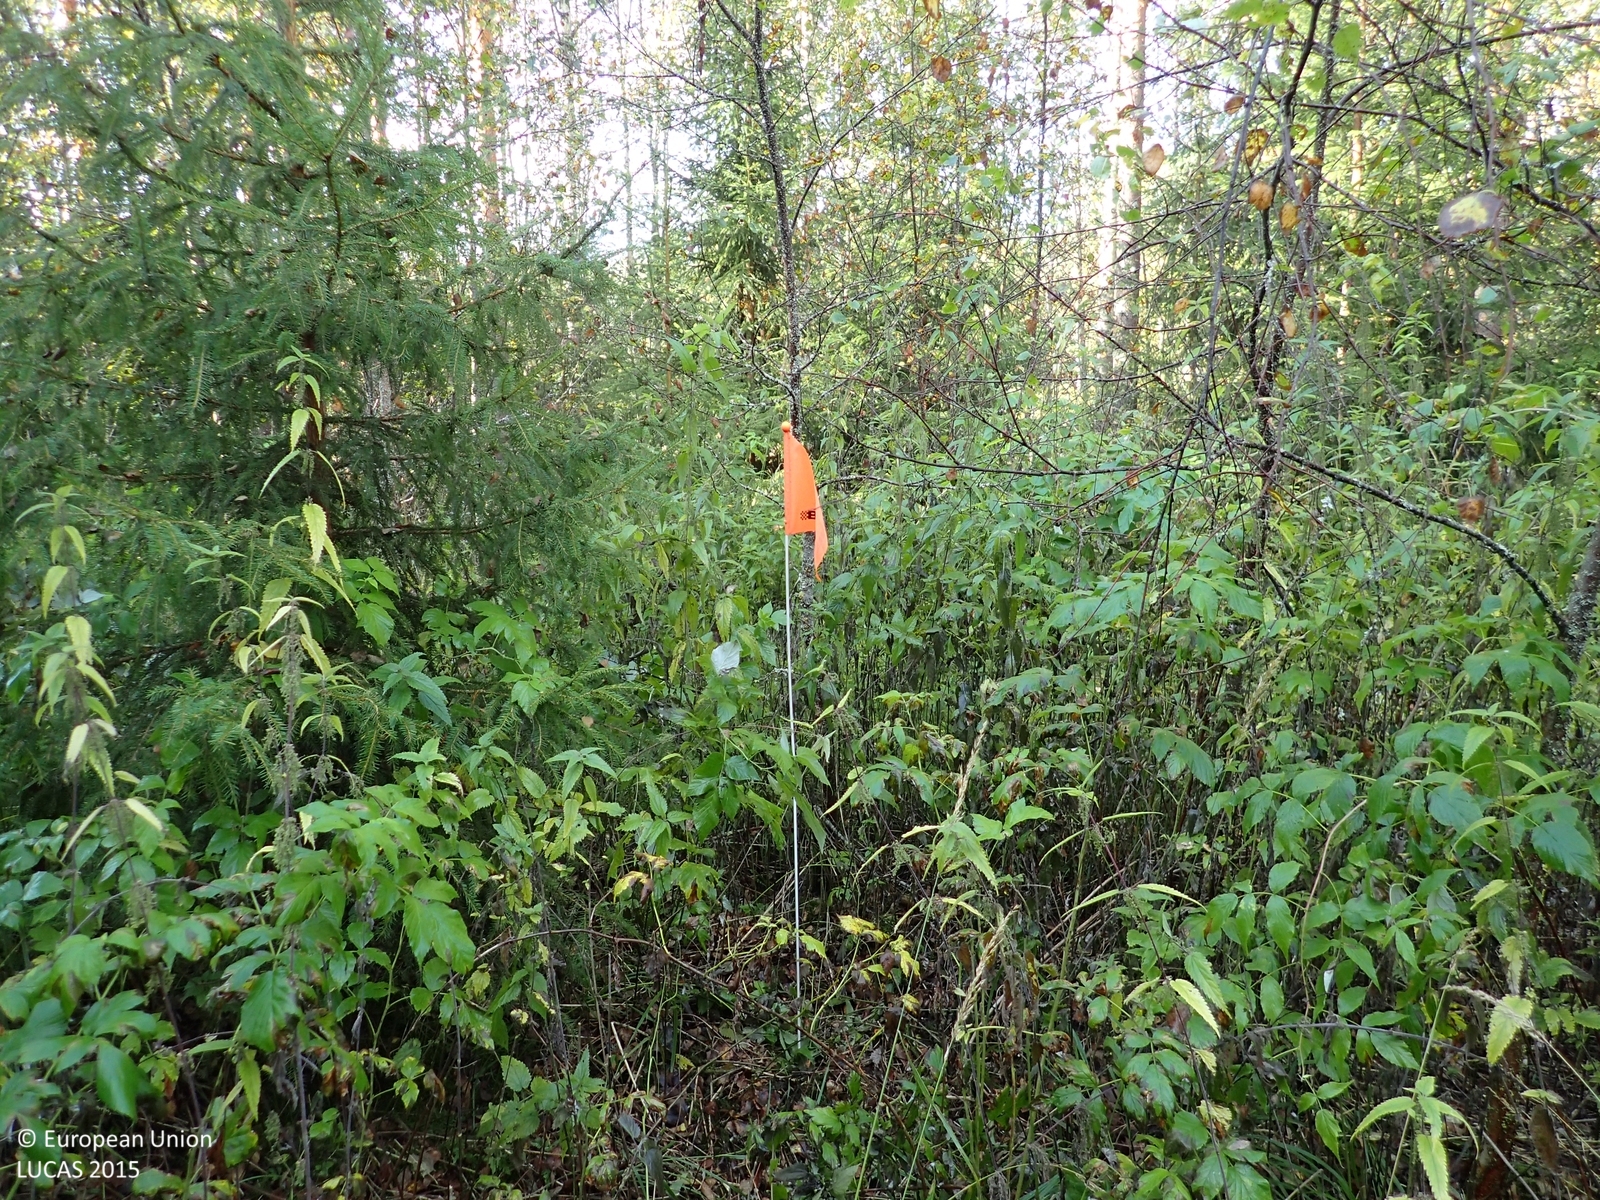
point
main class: Woodland
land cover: Spruce dominated mixed woodland
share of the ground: > 75 %
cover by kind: coniferous forest trees 55 %, herbaceous plants 25 %, broadleaved forest trees 20 %
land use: Forestry
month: September
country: FI
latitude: 63.0125
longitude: 25.5742
